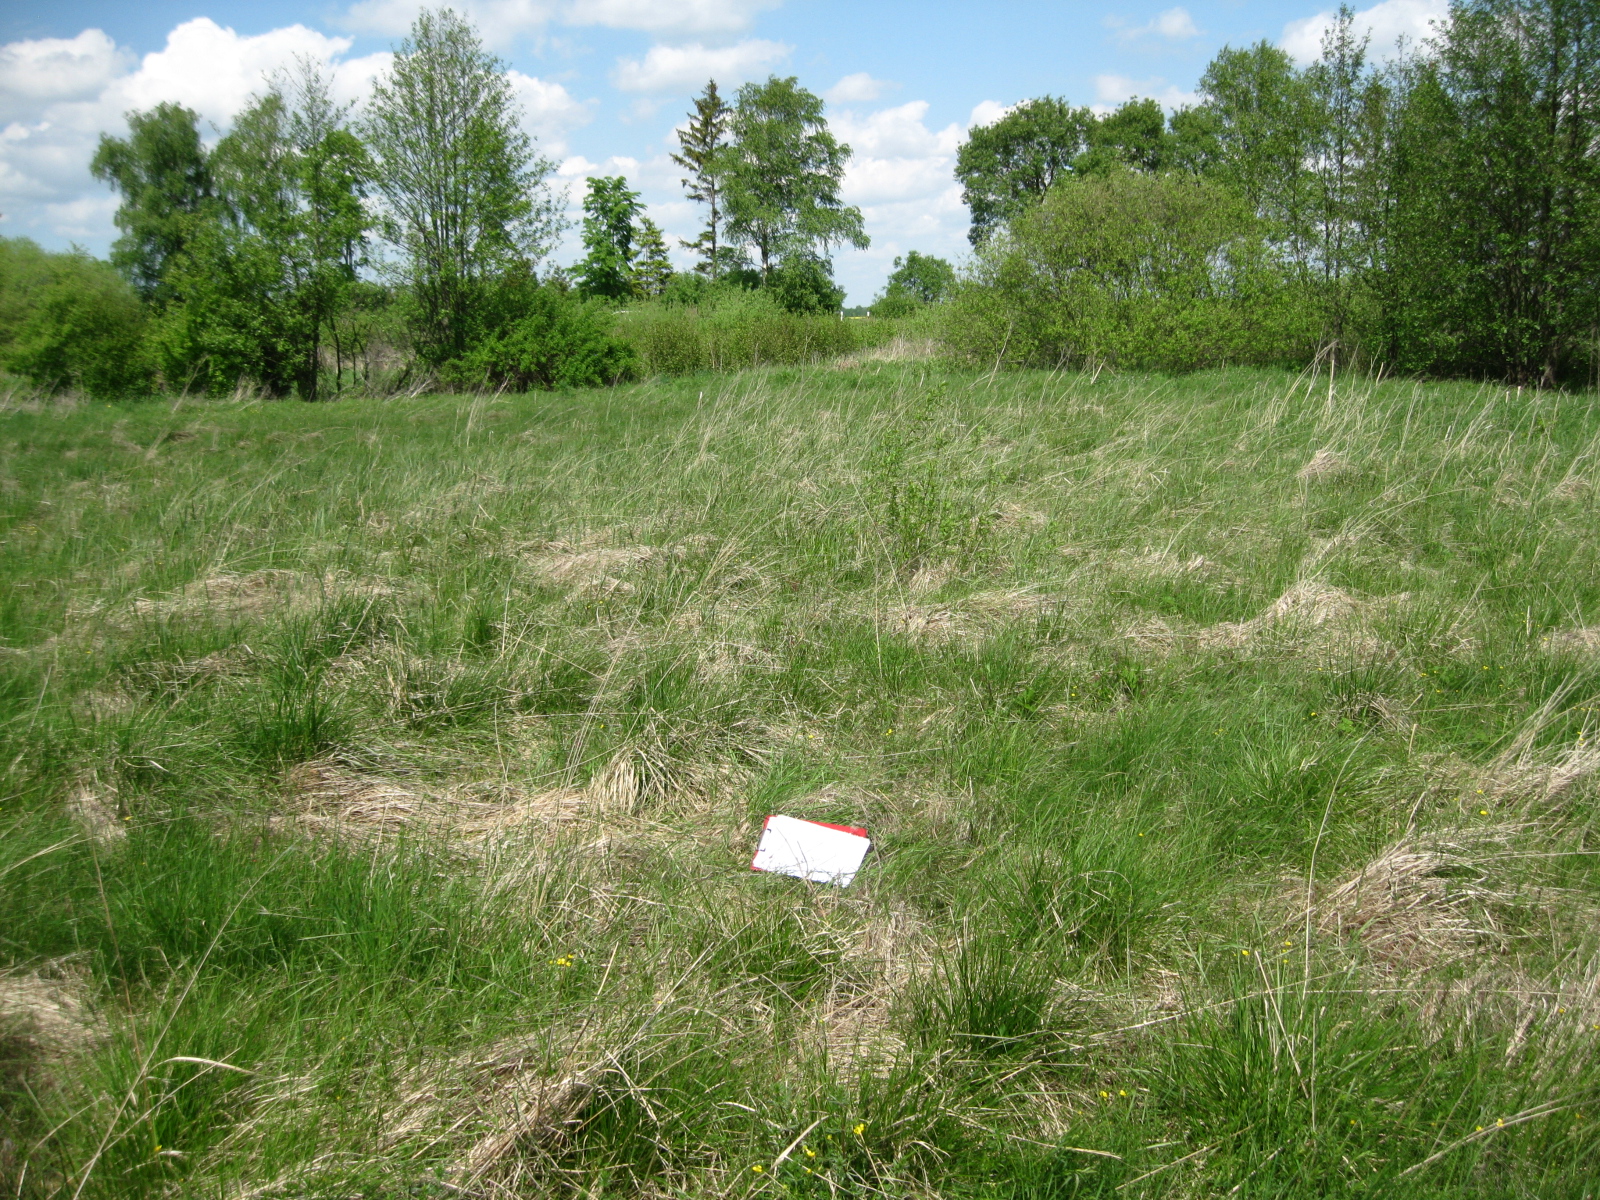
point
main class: Grassland
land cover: Grassland without tree/shrub cover
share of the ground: > 75 %
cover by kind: herbaceous plants 100 %
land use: Agriculture (excluding fallow land and kitchen gardens)
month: May
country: LT
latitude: 56.0399
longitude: 24.1348
